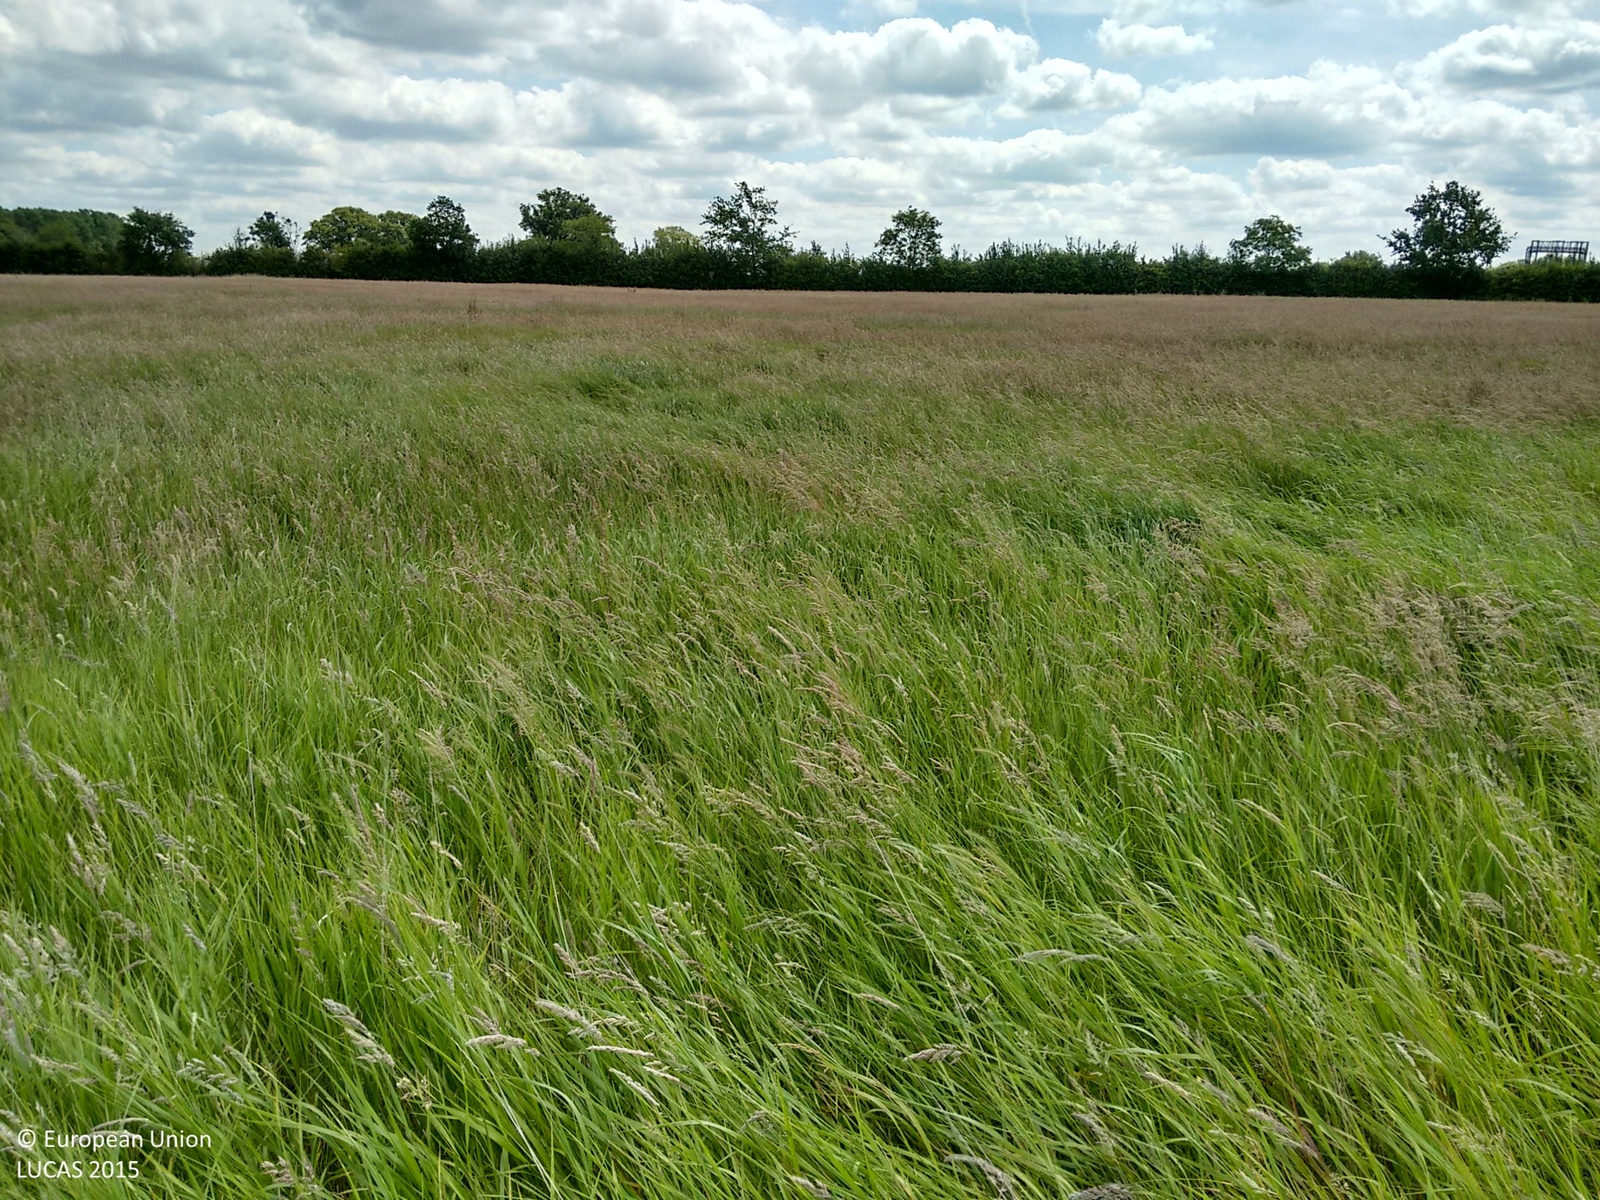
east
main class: Grassland
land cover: Grassland without tree/shrub cover
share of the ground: > 75 %
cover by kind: herbaceous plants 100 %
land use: Agriculture (excluding fallow land and kitchen gardens)
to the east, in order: Grassland without tree/shrub cover; Managed hedges; Artificial constructions; Grass margins; Paved roads, cycling and walking lanes; Grass margins; Managed hedges; Fences; Common wheat; Single bushes/trees
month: June
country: GB
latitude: 51.6134
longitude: -1.5326
